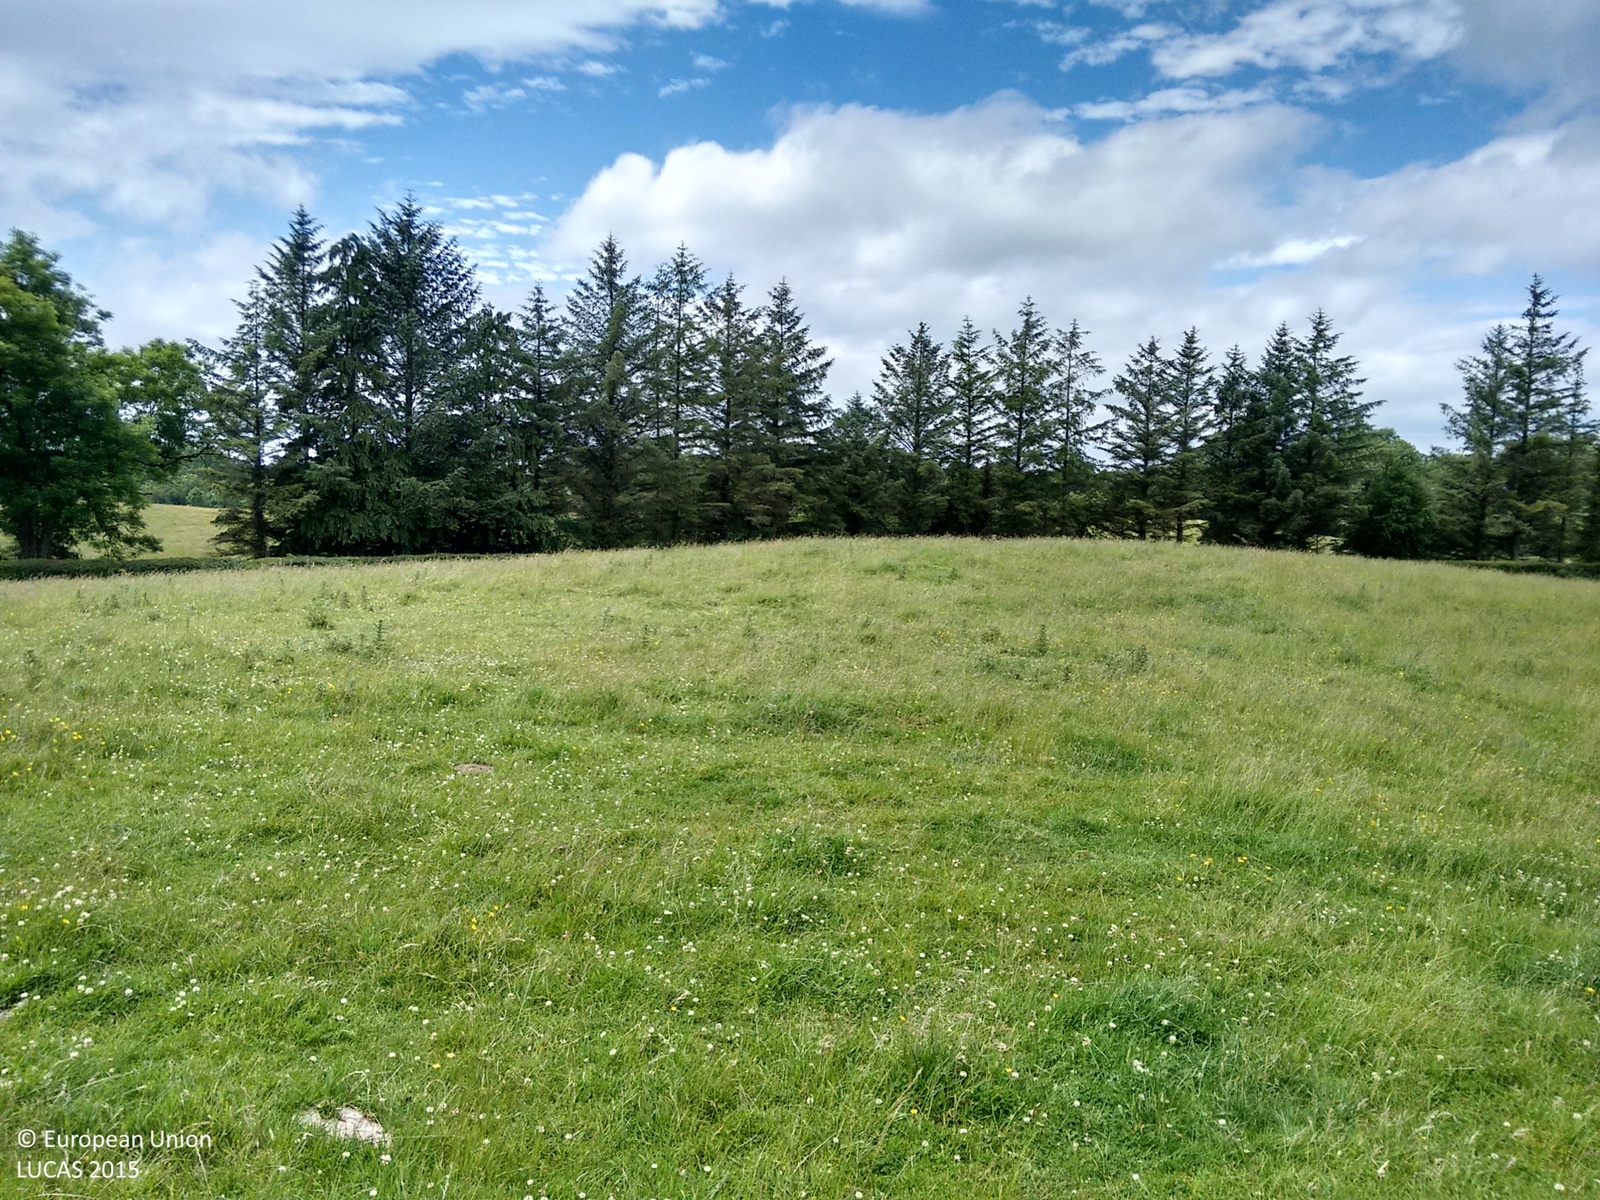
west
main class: Grassland
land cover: Grassland without tree/shrub cover
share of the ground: > 75 %
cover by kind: herbaceous plants 100 %
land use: Agriculture (excluding fallow land and kitchen gardens)
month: June
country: IE
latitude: 53.6704
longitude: -7.0503
